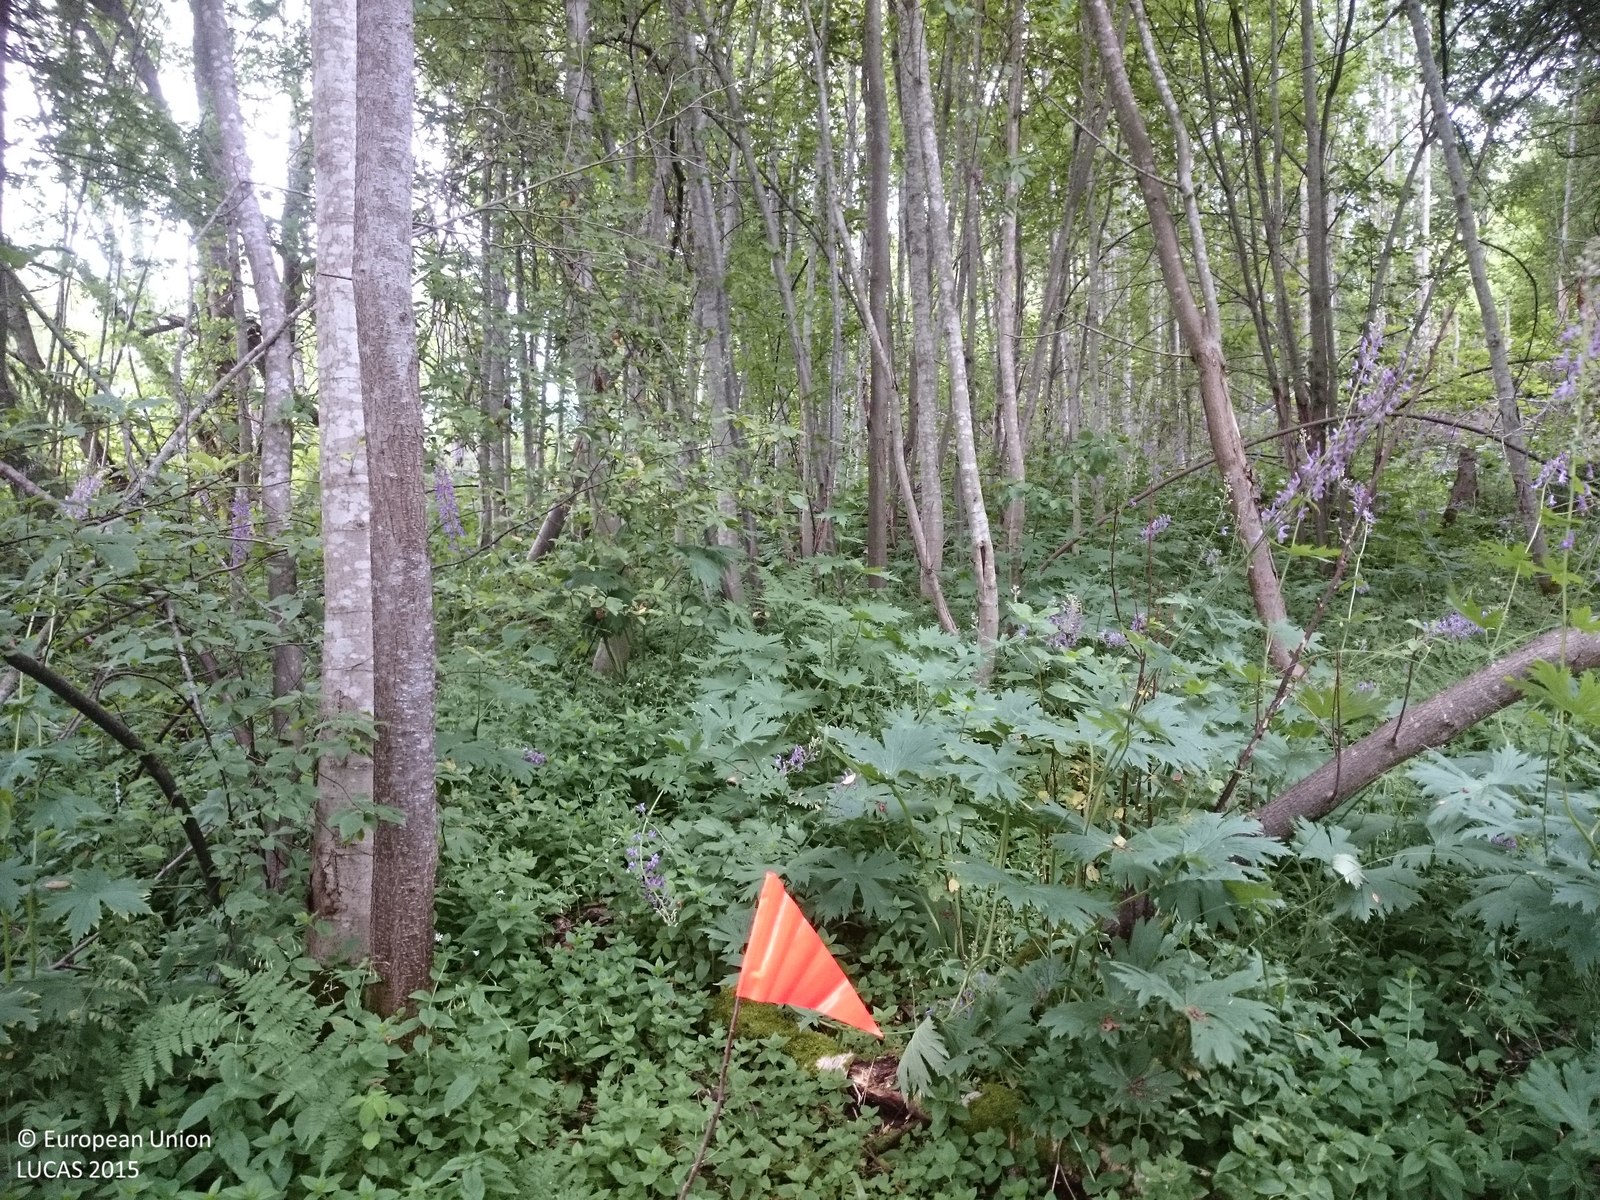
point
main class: Woodland
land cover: Broadleaved woodland
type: boreal forest
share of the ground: > 75 %
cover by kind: broadleaved forest trees 60 %, herbaceous plants 25 %, coniferous forest trees 15 %
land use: Forestry
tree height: > 5 m
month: July
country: SE
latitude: 62.4784
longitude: 17.5264
